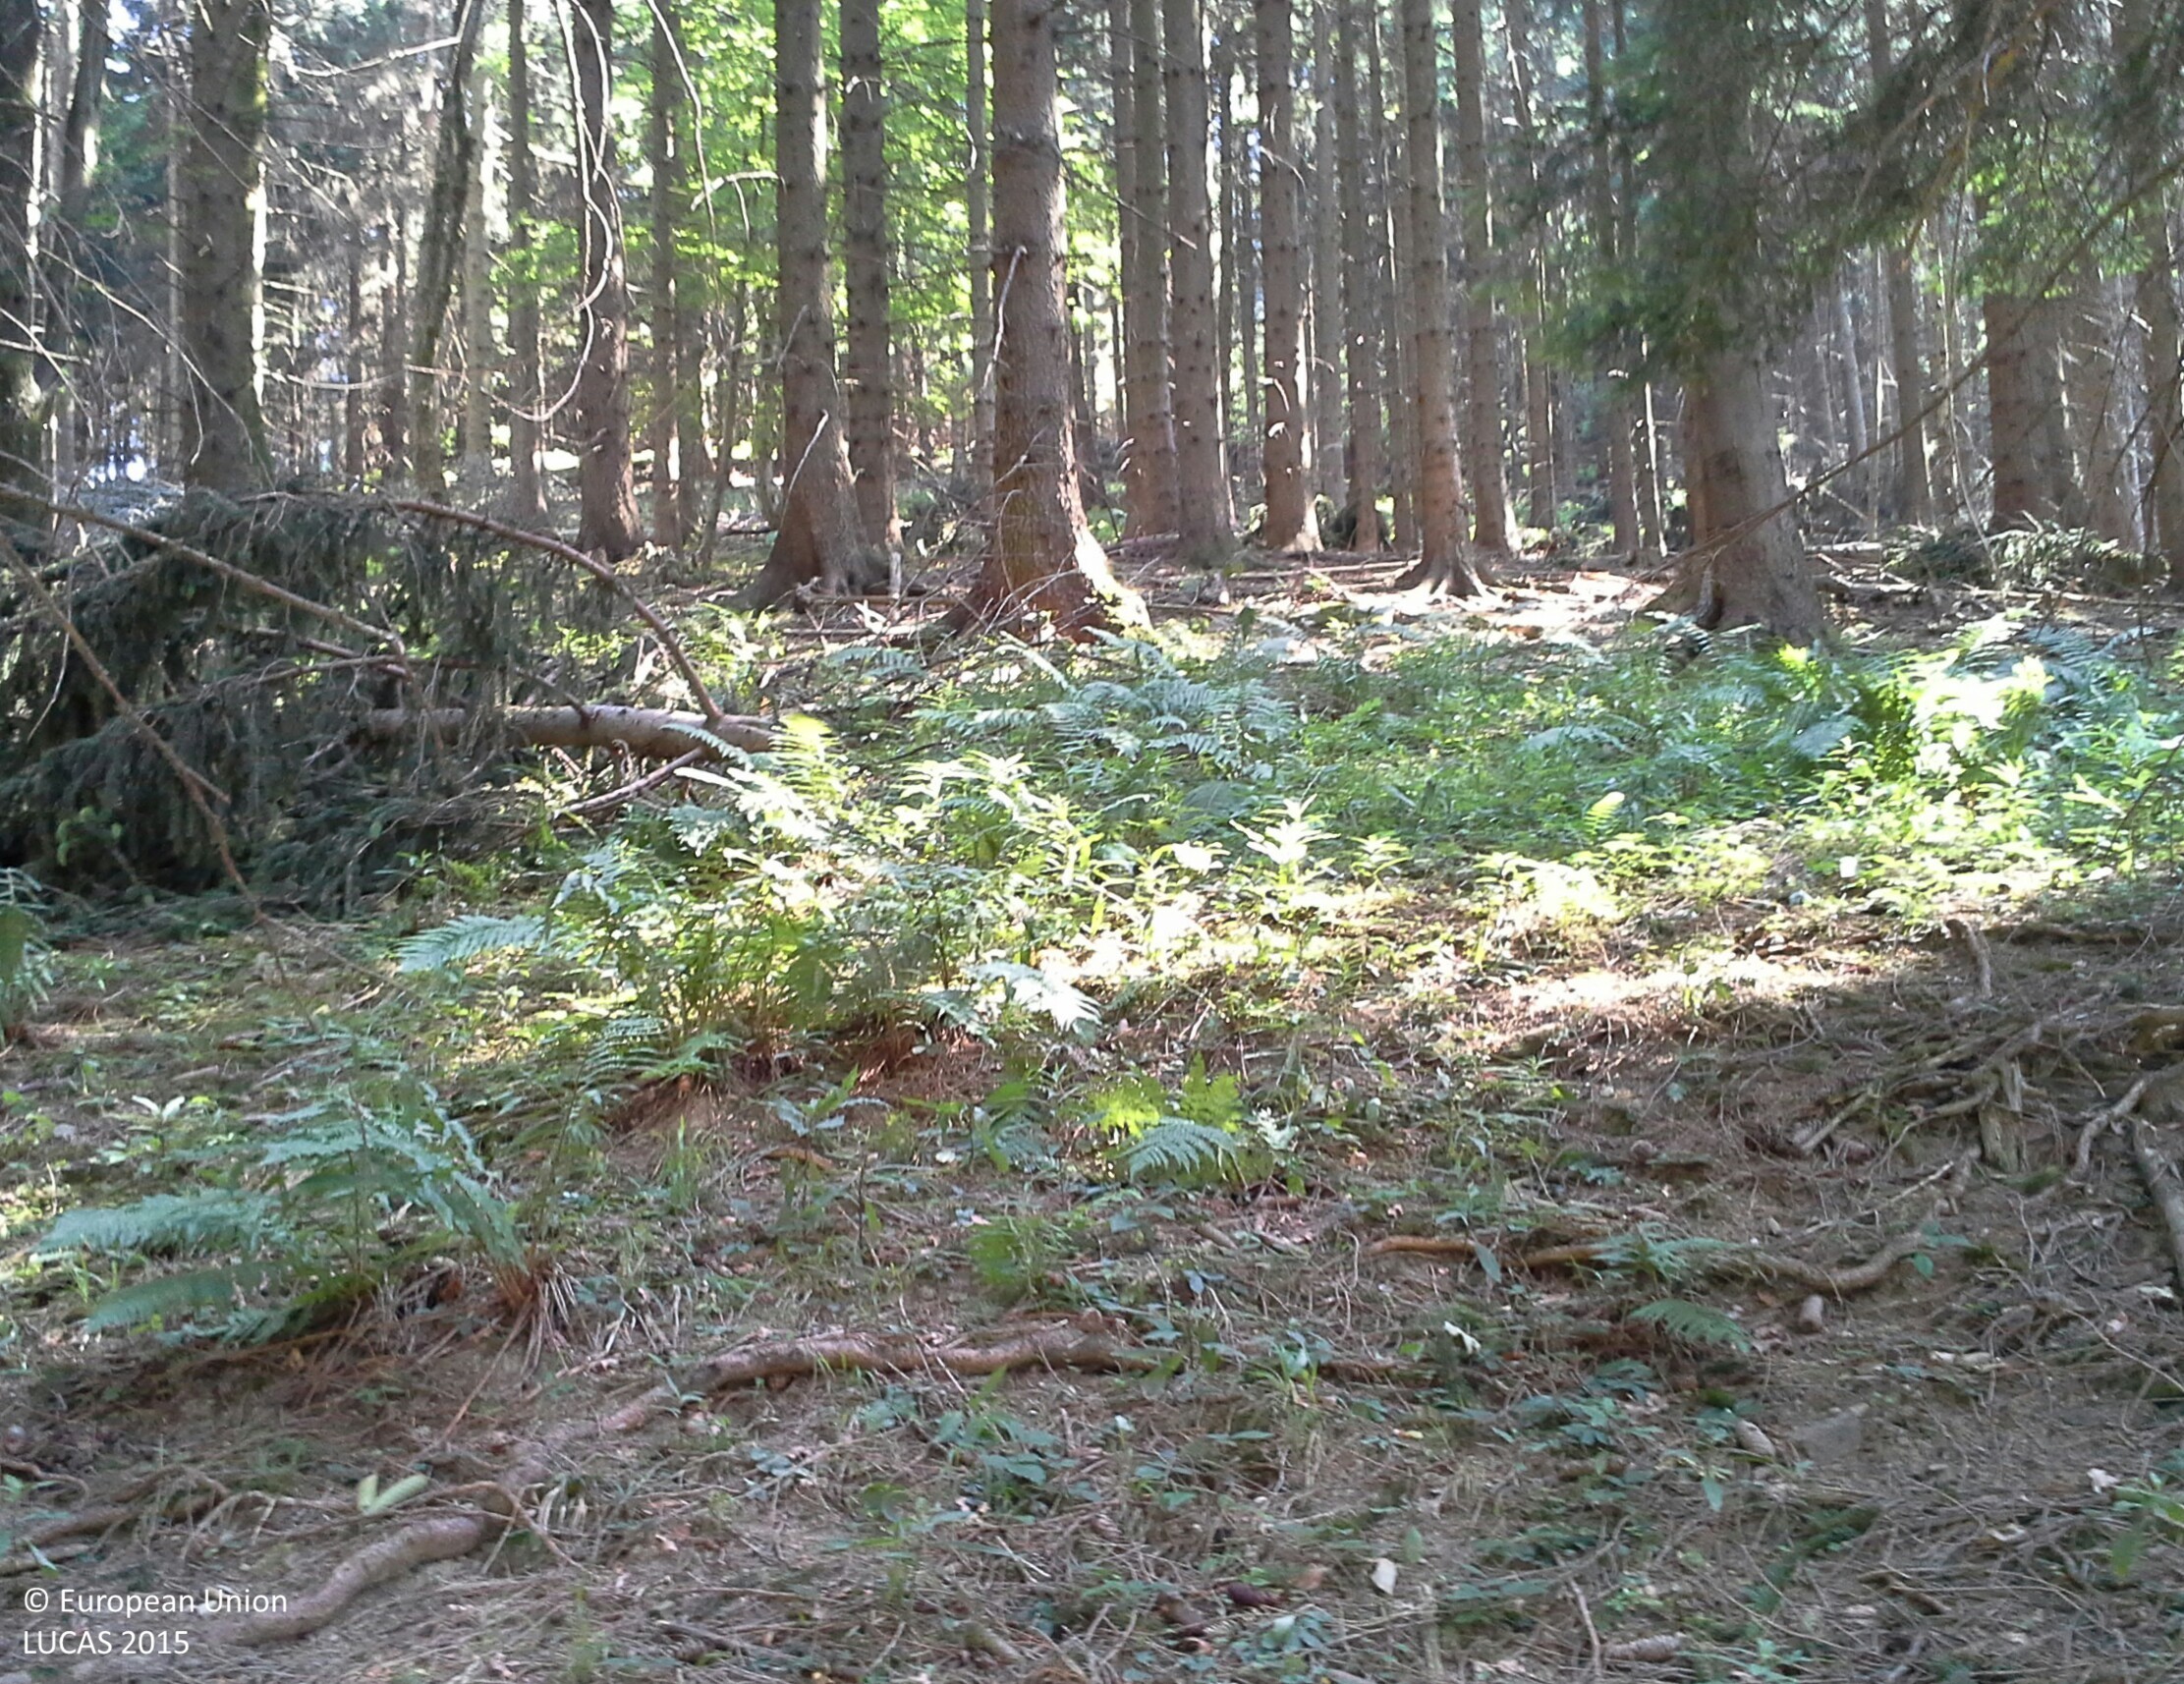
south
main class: Woodland
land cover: Spruce dominated coniferous woodland
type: alpine coniferous forest
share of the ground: > 75 %
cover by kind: coniferous forest trees 90 %, herbaceous plants 10 %
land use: Forestry
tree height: > 5 m
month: July
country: AT
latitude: 47.9611
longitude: 14.7010
